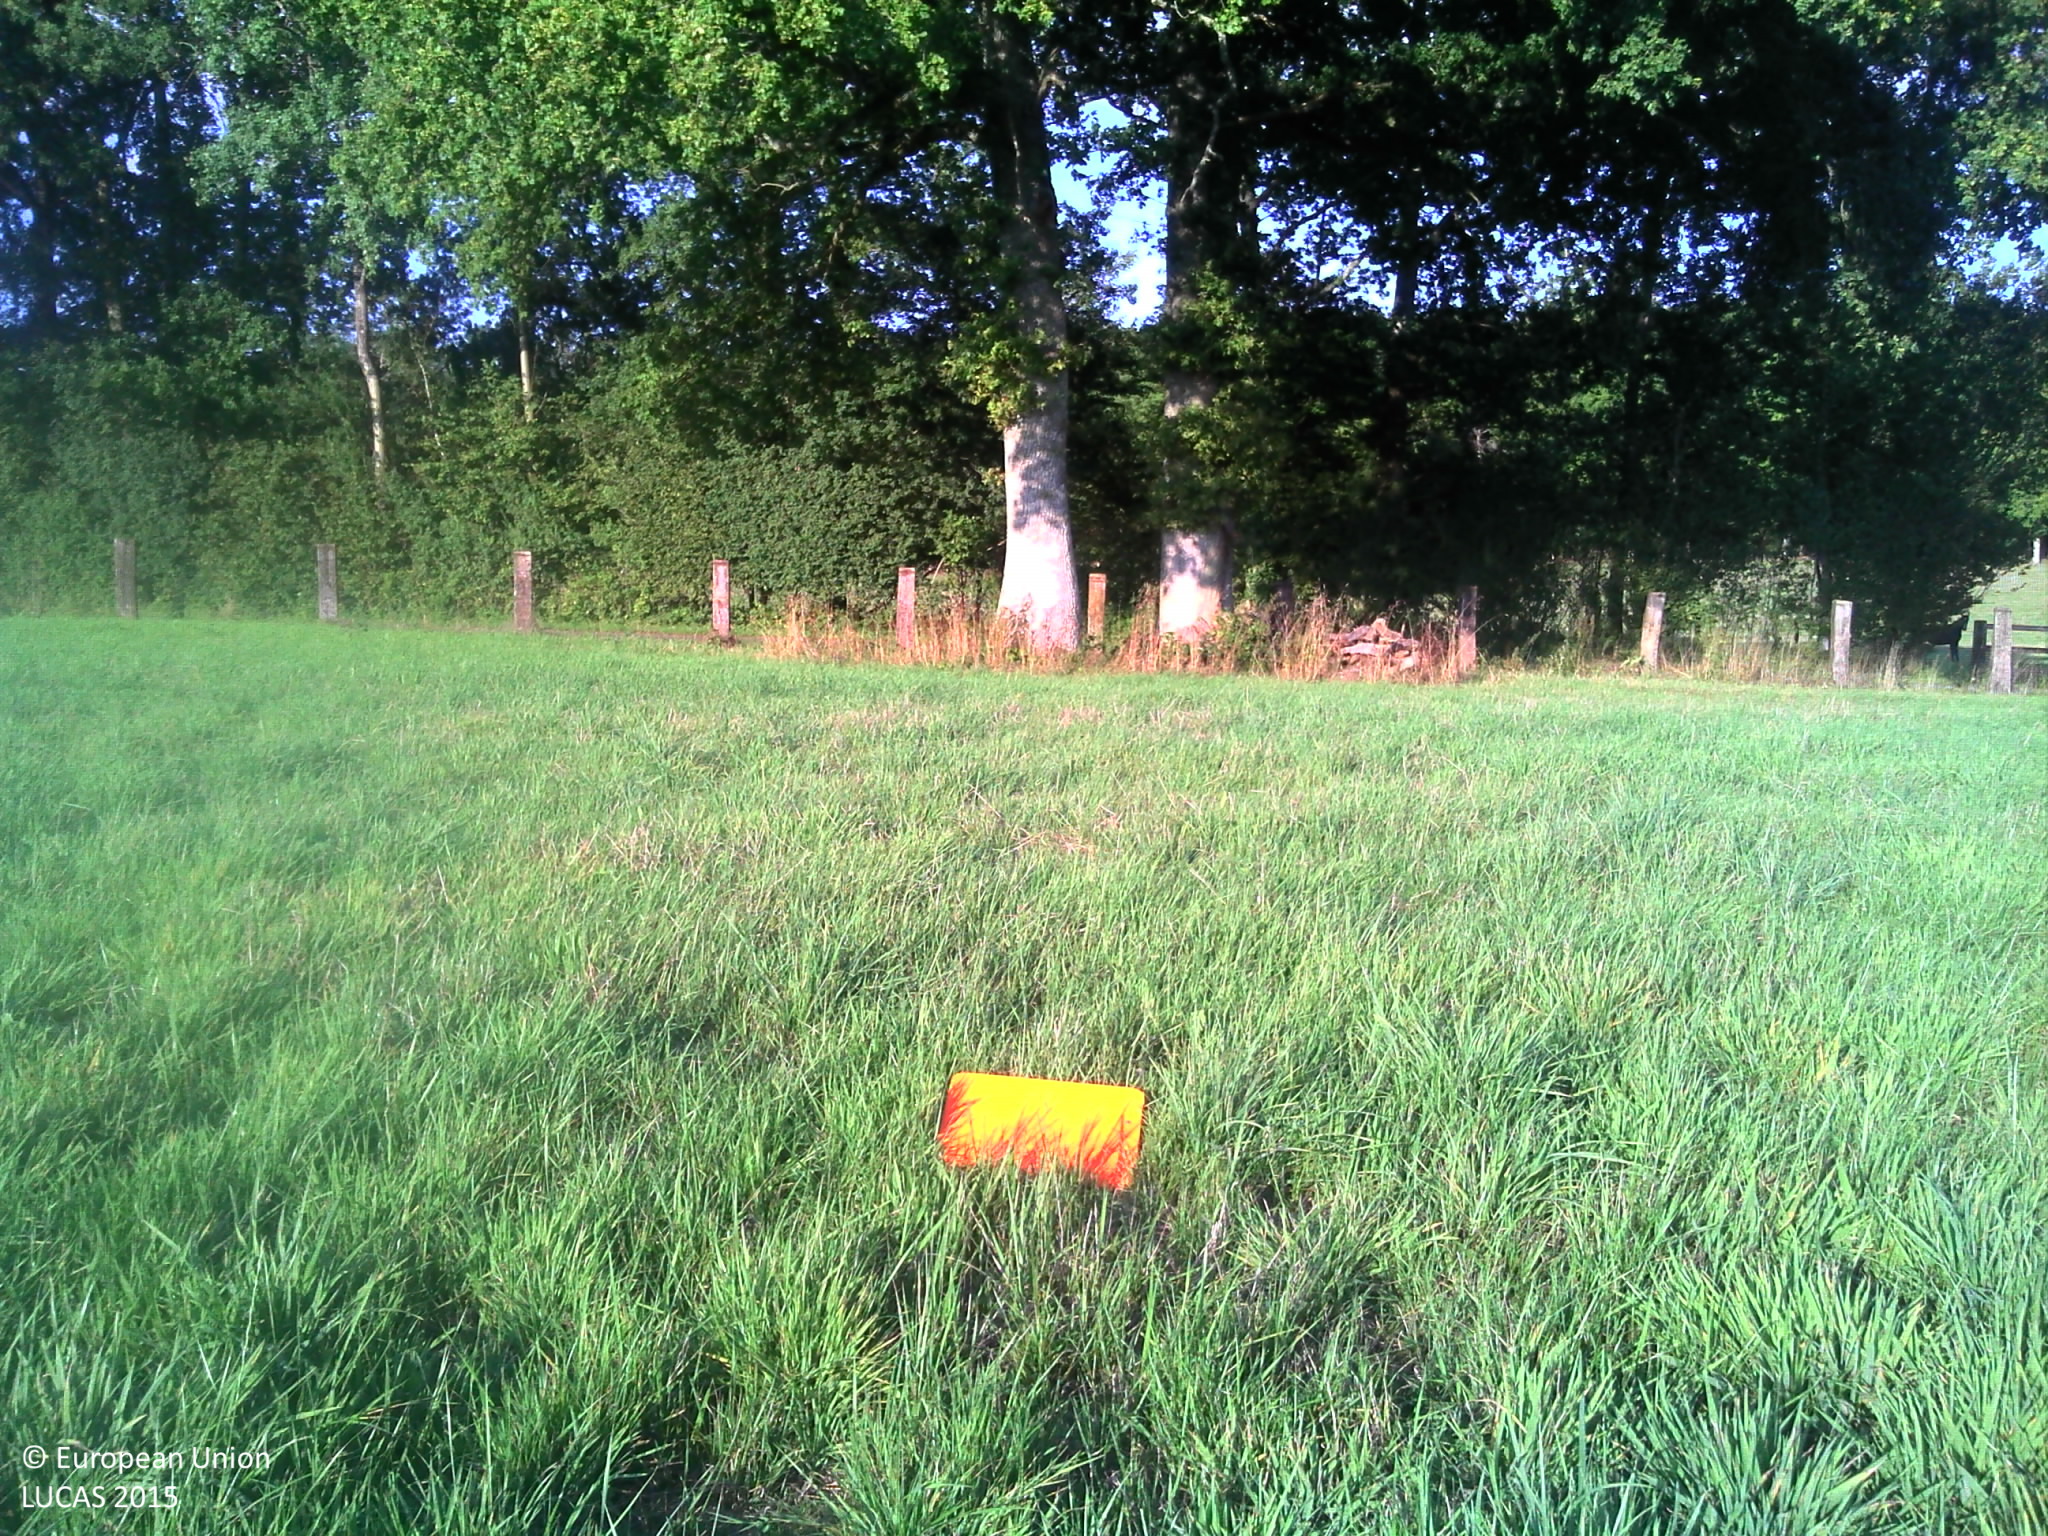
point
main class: Grassland
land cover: Grassland without tree/shrub cover
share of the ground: > 75 %
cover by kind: herbaceous plants 100 %
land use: Agriculture (excluding fallow land and kitchen gardens)
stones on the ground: < 10 %
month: September
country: FR
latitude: 48.4107
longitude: 0.5049
